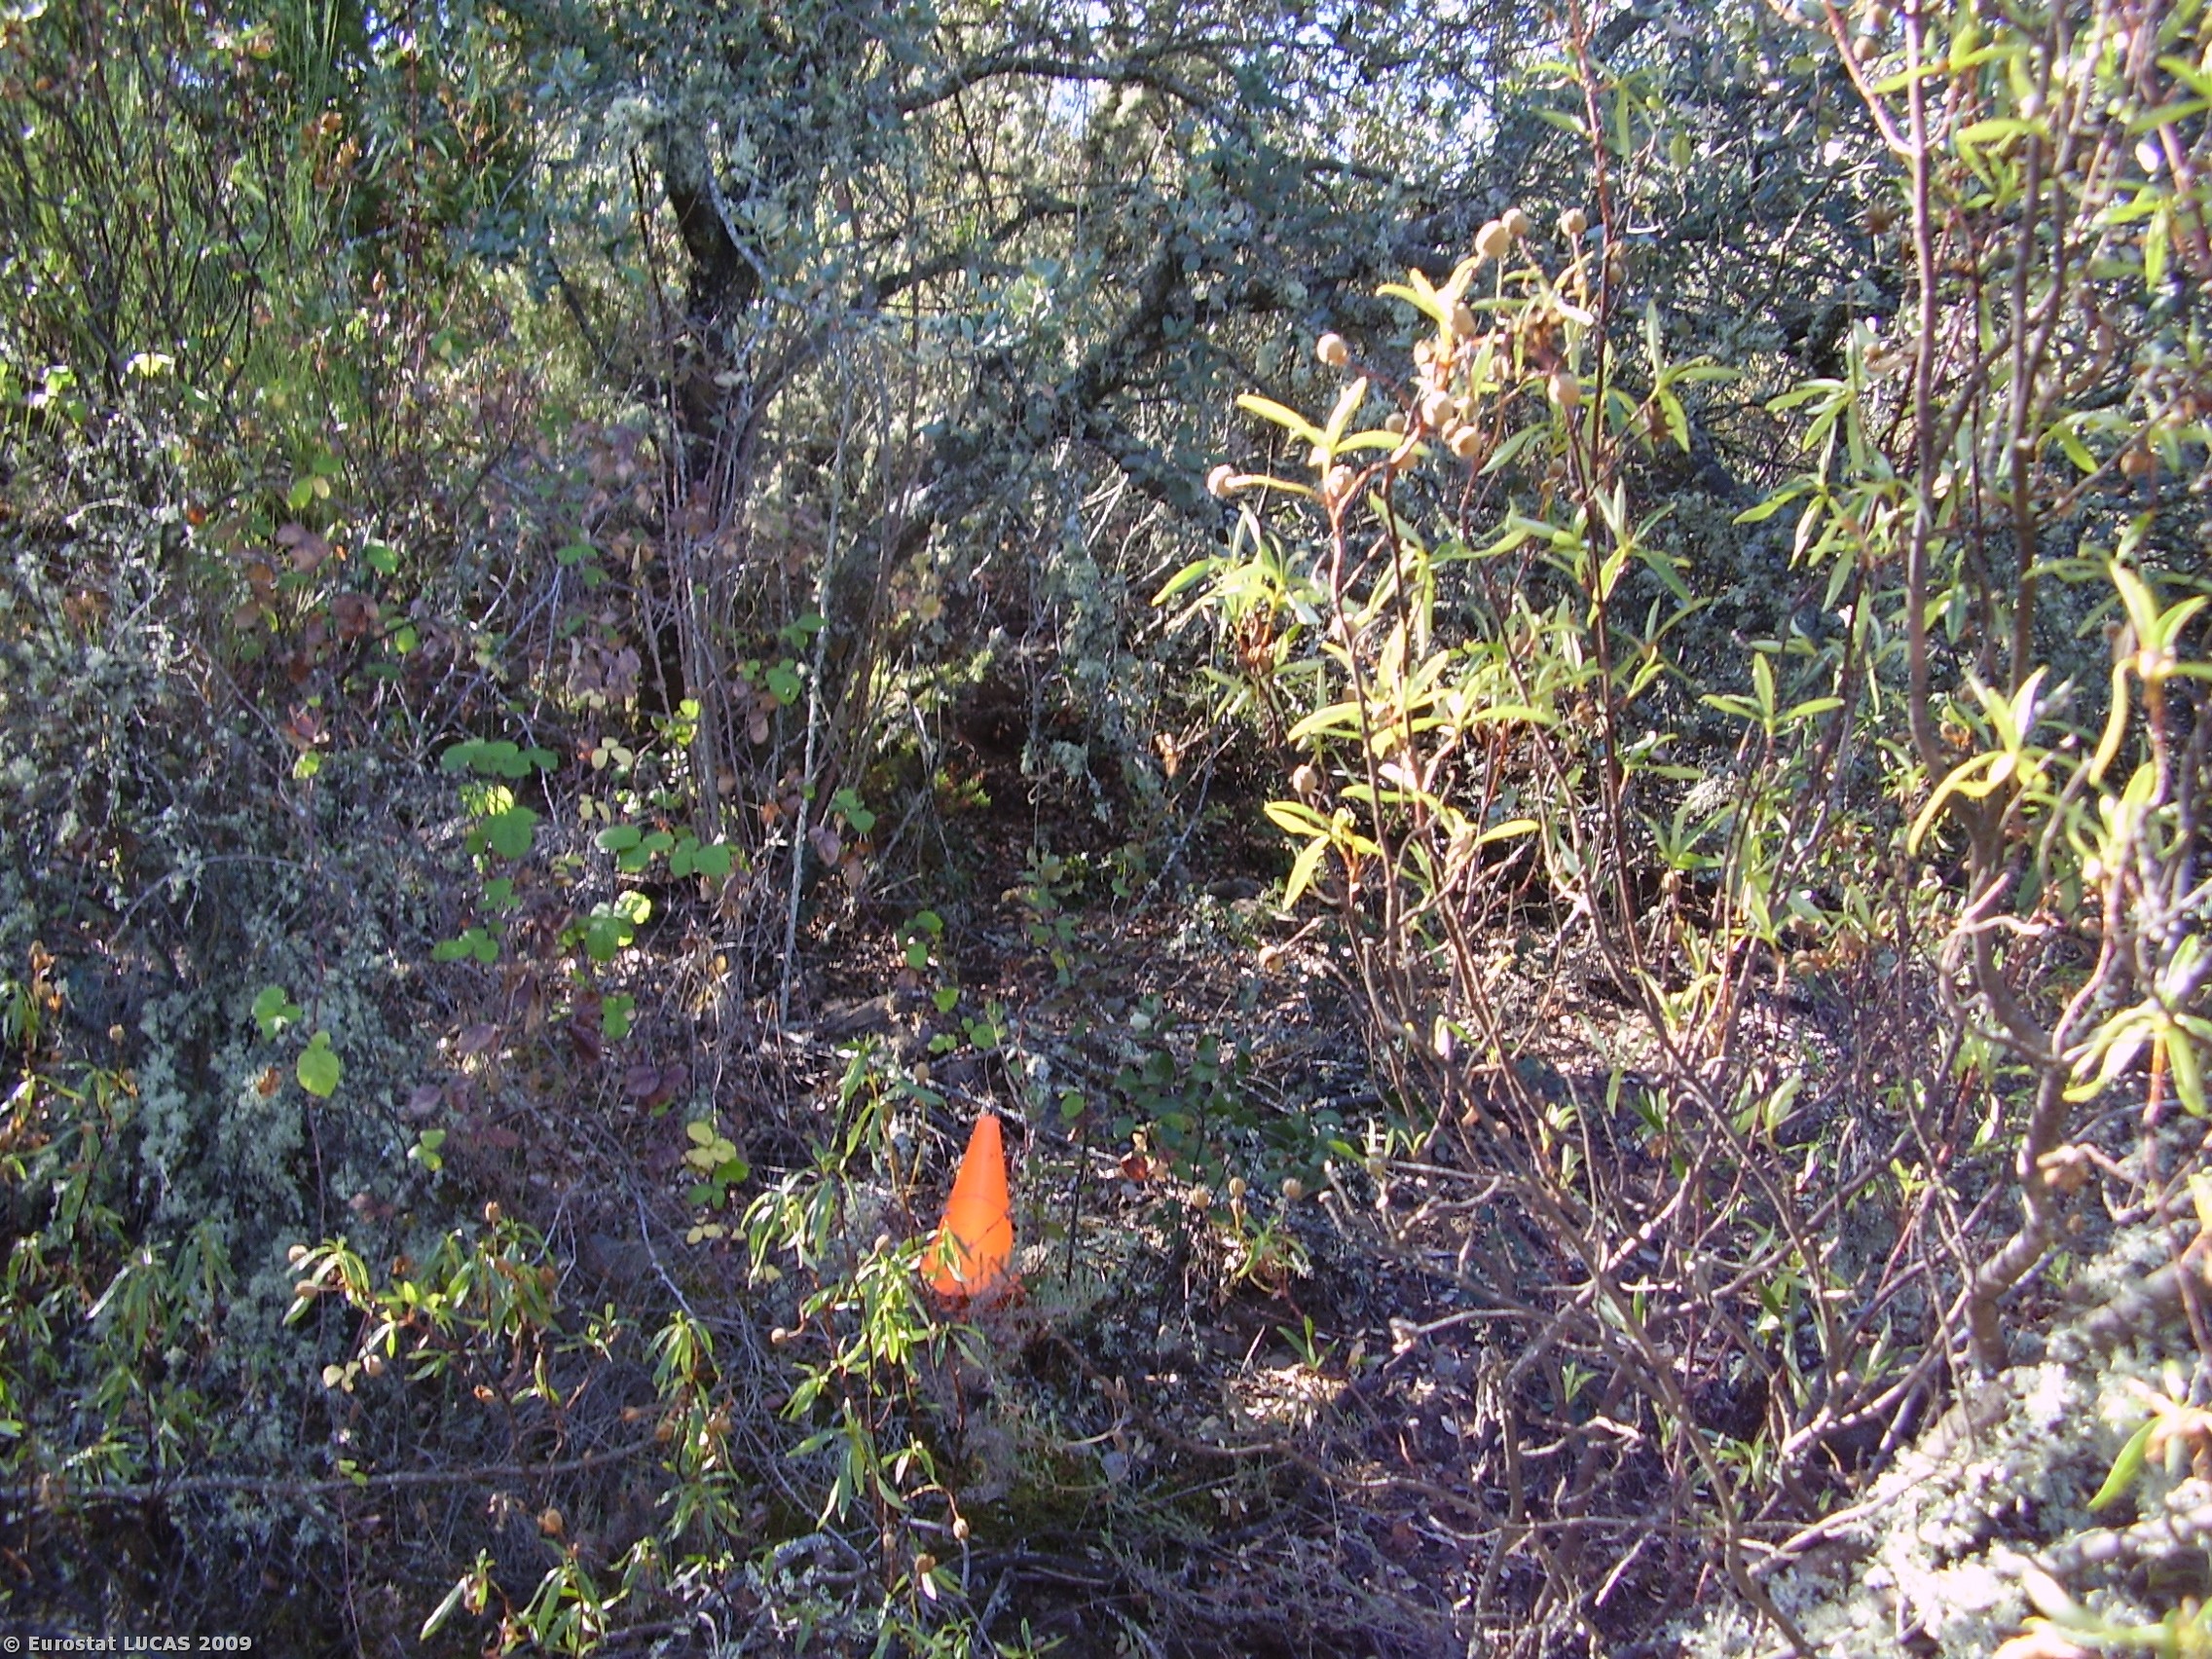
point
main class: Woodland
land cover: Broadleaved woodland
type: broadleaved evergreen forest
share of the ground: 10 - 25 %
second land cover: Shrubland with sparse tree cover
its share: > 75 %
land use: Forestry
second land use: Fallow land
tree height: > 5 m
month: August
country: PT
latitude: 41.3958
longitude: -6.7436
